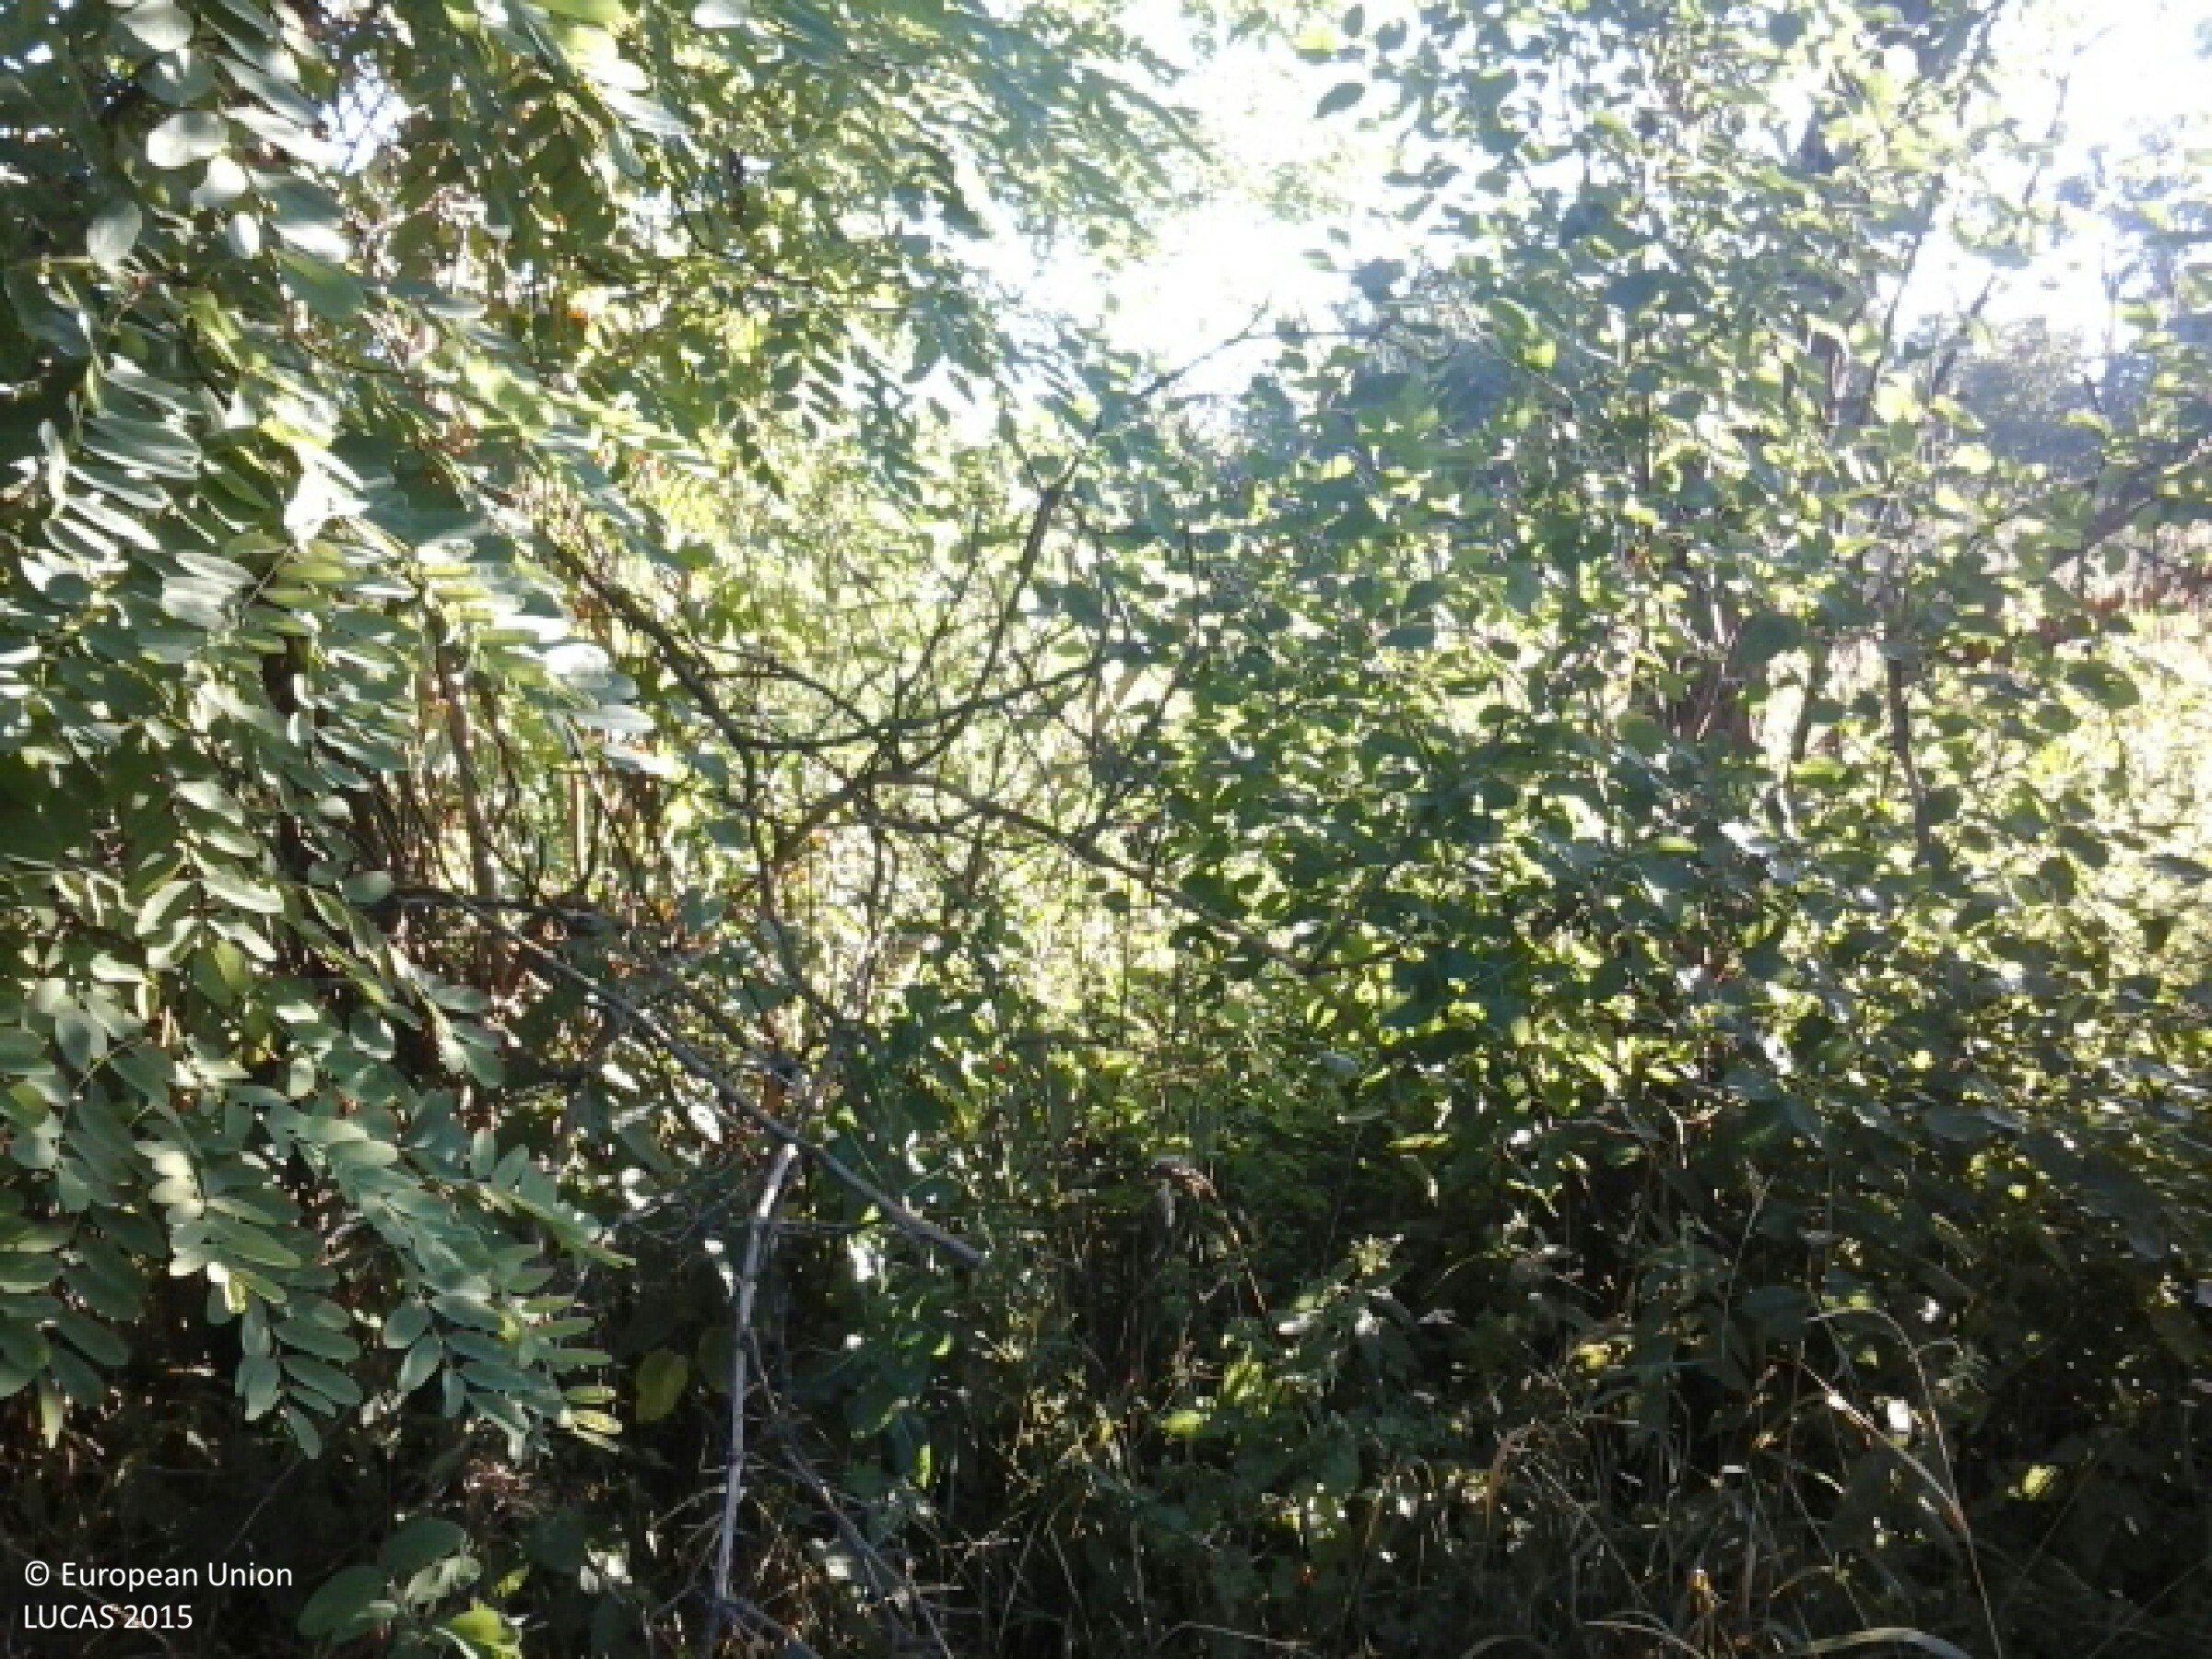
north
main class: Grassland
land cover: Grassland with sparse tree/shrub cover
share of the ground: > 75 %
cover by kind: herbaceous plants 90 %, broadleaved forest trees 5 %, shrubs 5 %
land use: Residential
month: July
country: HU
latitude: 48.2932
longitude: 21.1348
